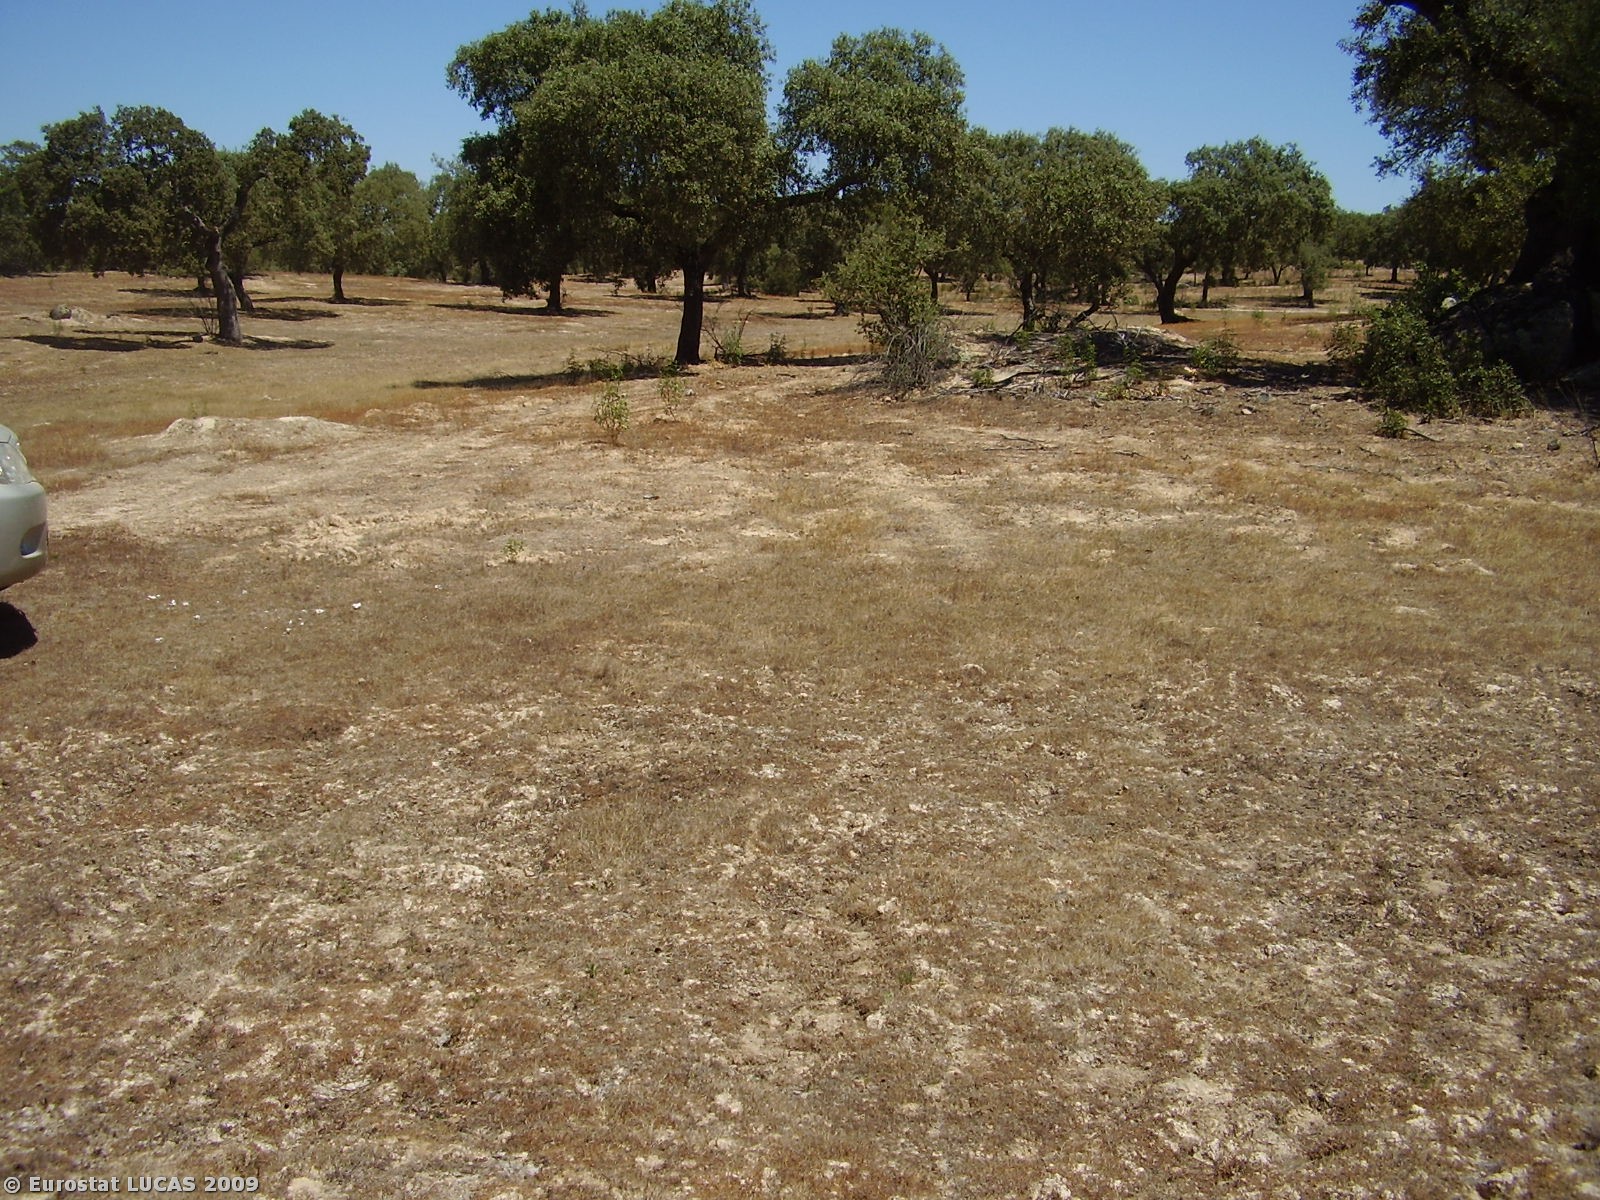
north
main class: Woodland
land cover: Broadleaved woodland
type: broadleaved evergreen forest
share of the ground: 10 - 25 %
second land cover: Grassland with sparse tree/shrub cover
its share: 50 - 75 %
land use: Forestry
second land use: Agriculture (excluding fallow land and kitchen gardens)
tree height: > 5 m
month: July
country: PT
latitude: 38.8743
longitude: -7.9466
